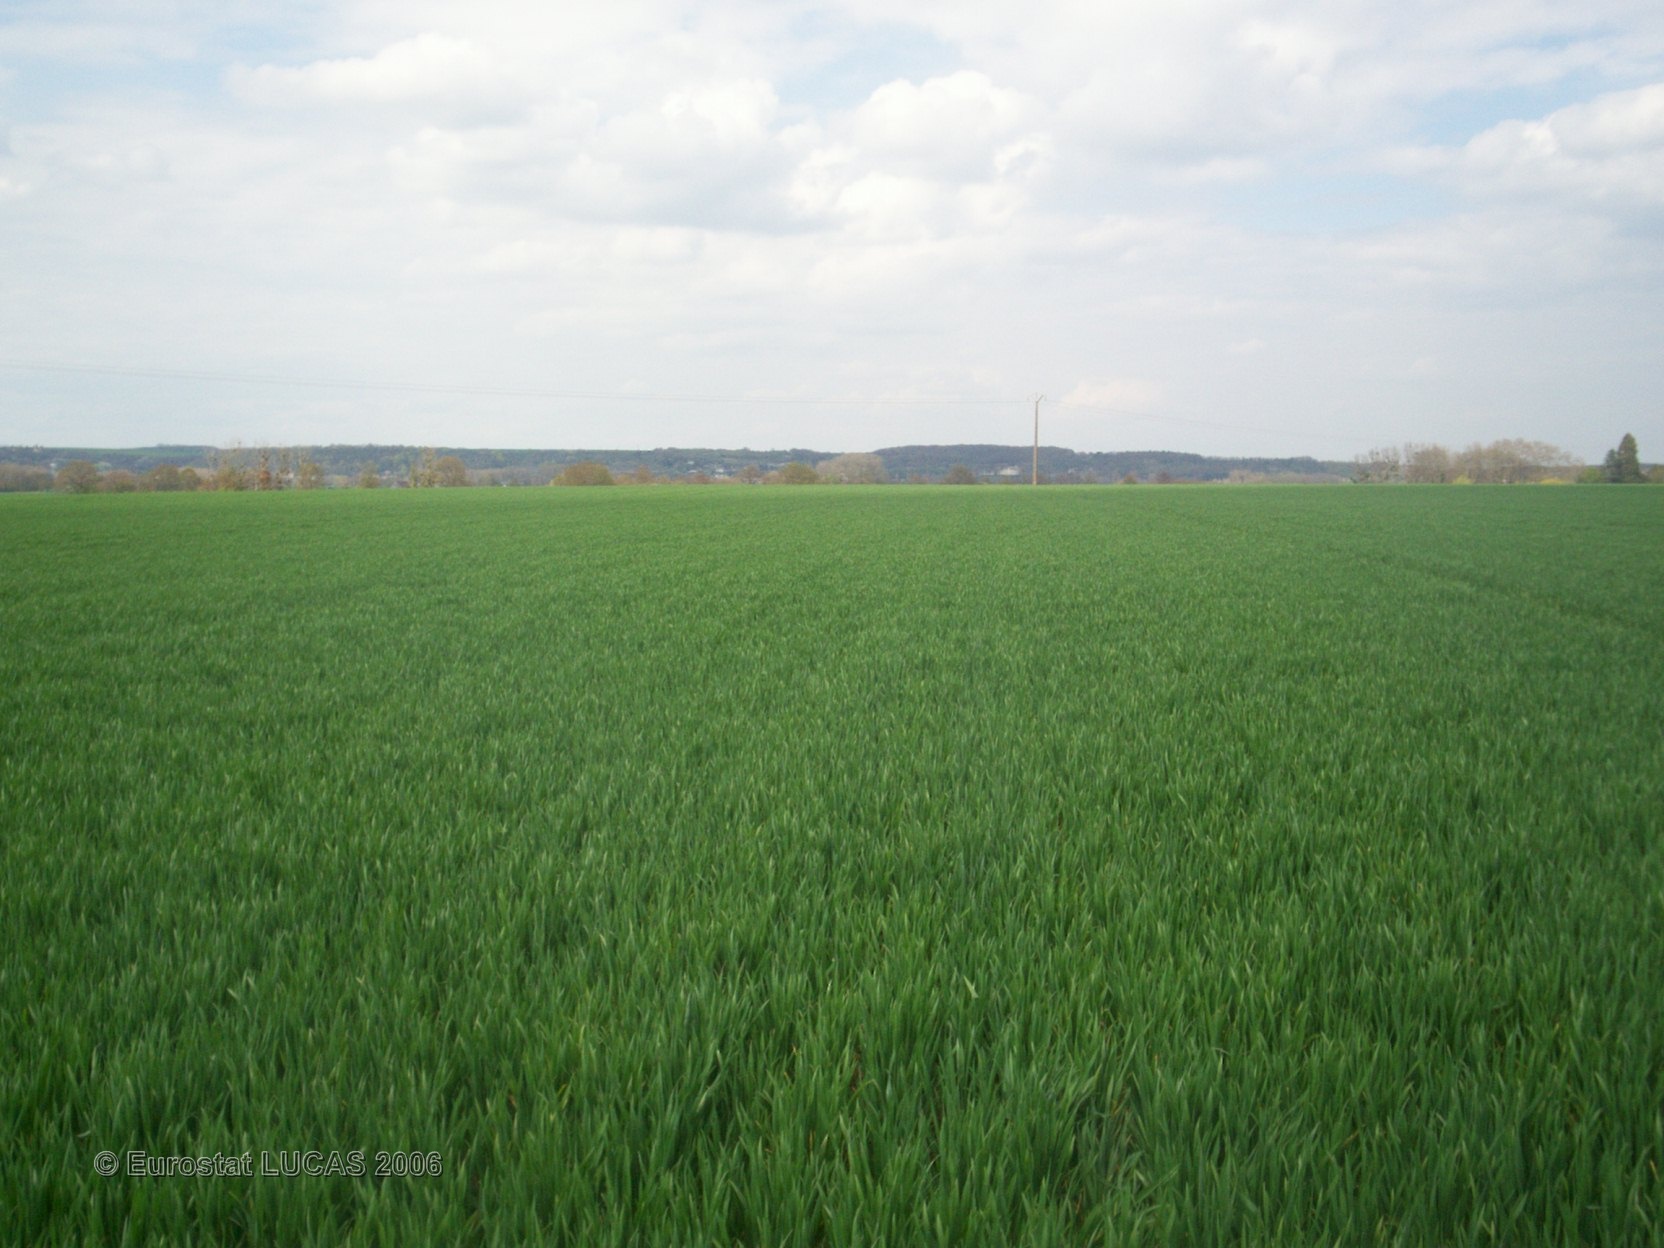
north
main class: Cropland
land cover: Common wheat
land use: Agriculture (excluding fallow land and kitchen gardens)
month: April
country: FR
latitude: 47.7490
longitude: 0.8169
